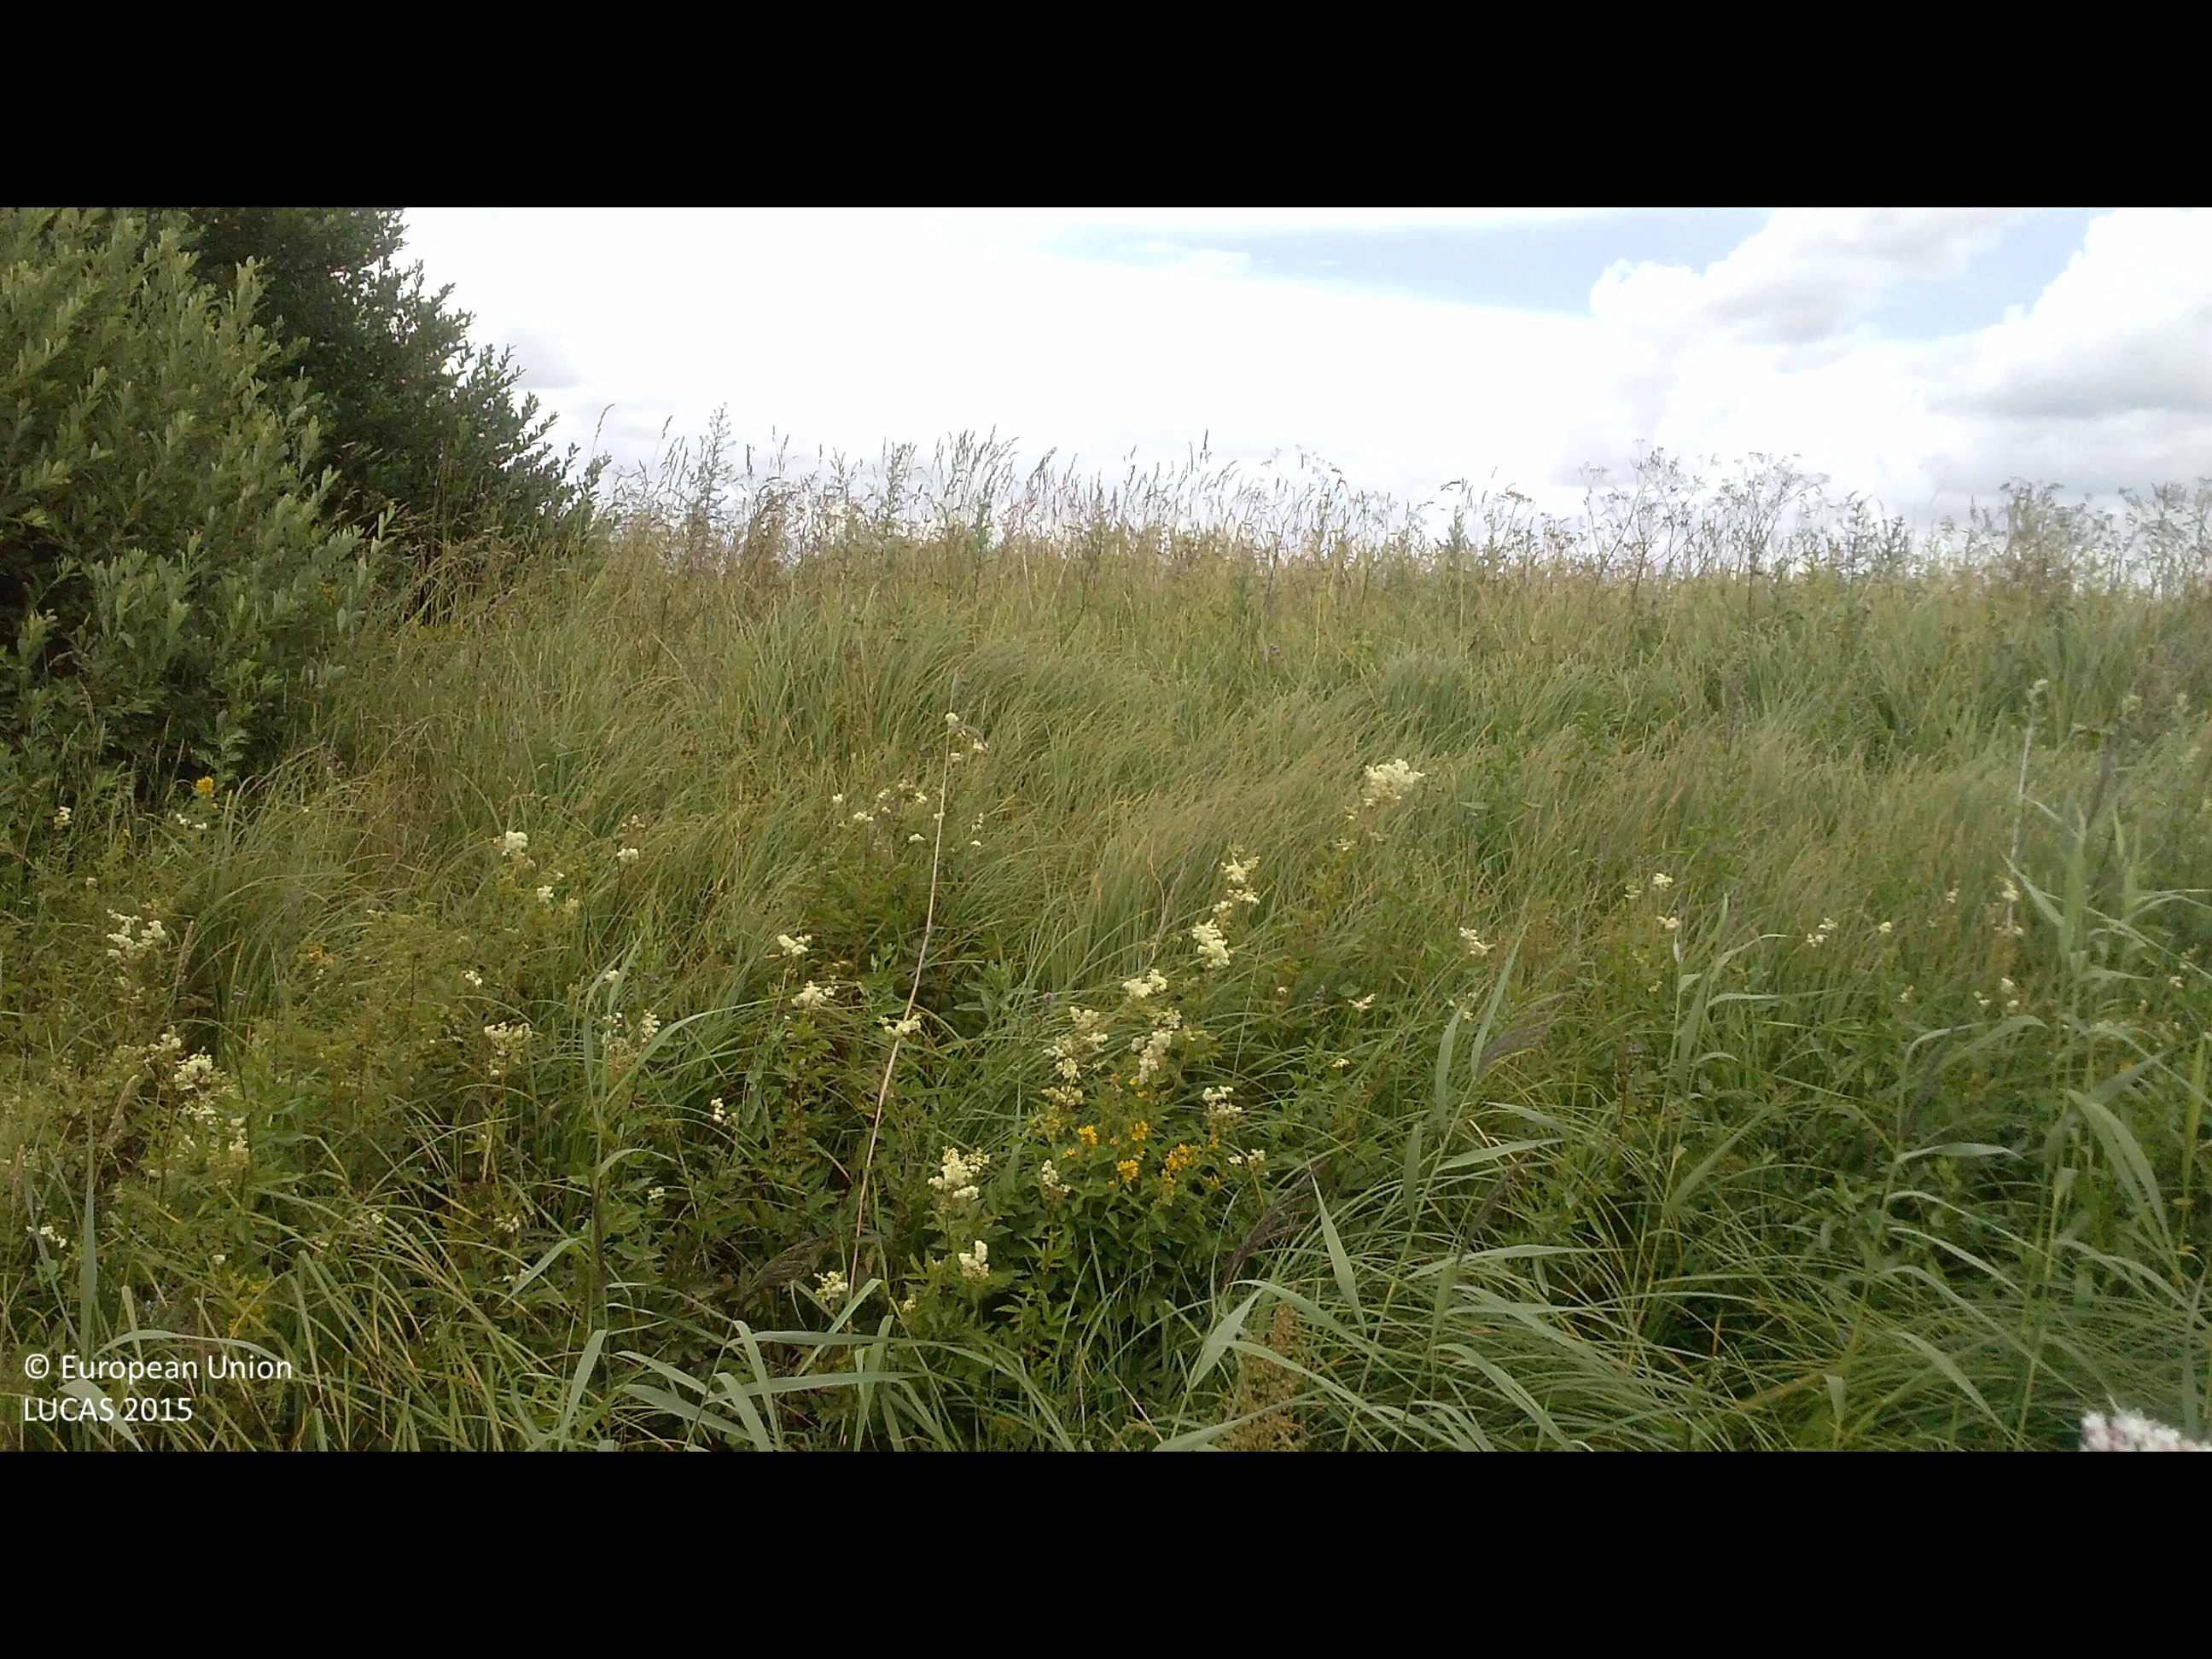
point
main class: Grassland
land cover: Spontaneously vegetated surfaces
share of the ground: > 75 %
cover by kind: herbaceous plants 100 %
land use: Semi-natural and natural areas not in use
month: July
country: LV
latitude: 56.4434
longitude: 26.9842
